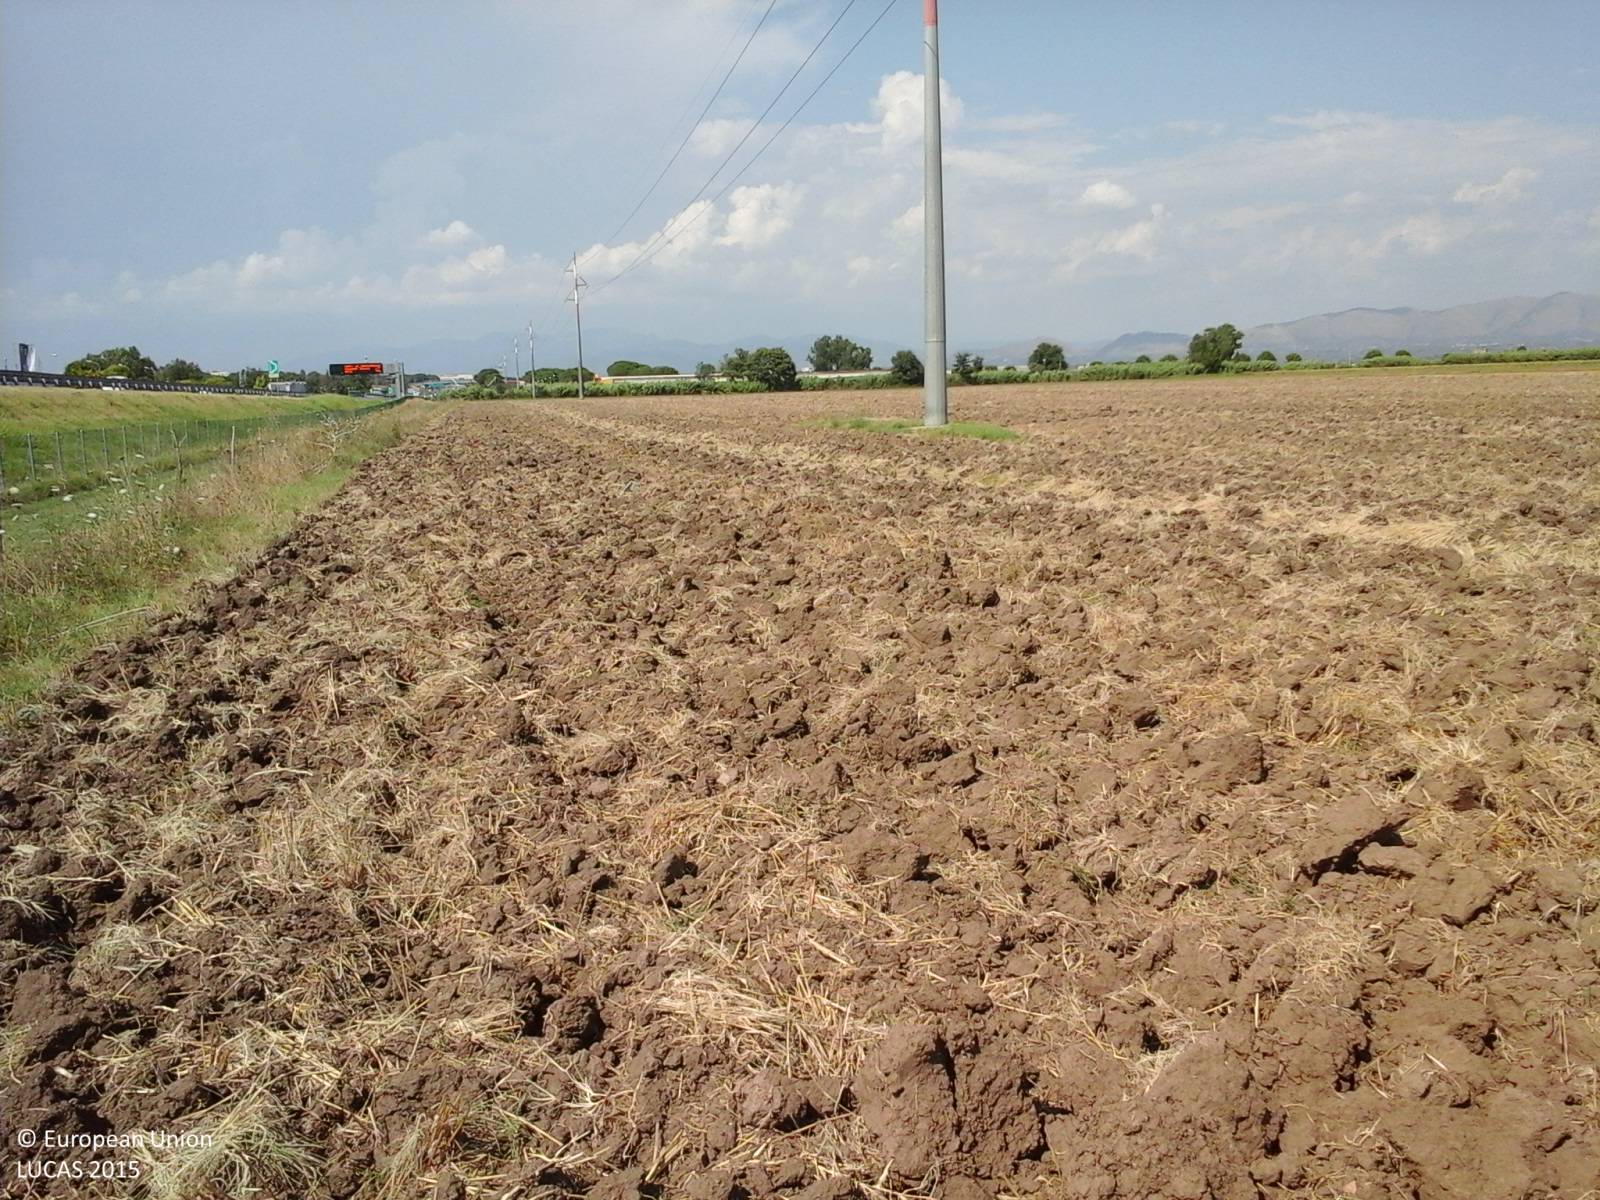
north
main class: Cropland
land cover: Durum wheat
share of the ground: < 10 %
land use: Agriculture (excluding fallow land and kitchen gardens)
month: July
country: IT
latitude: 42.1148
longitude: 12.5911
